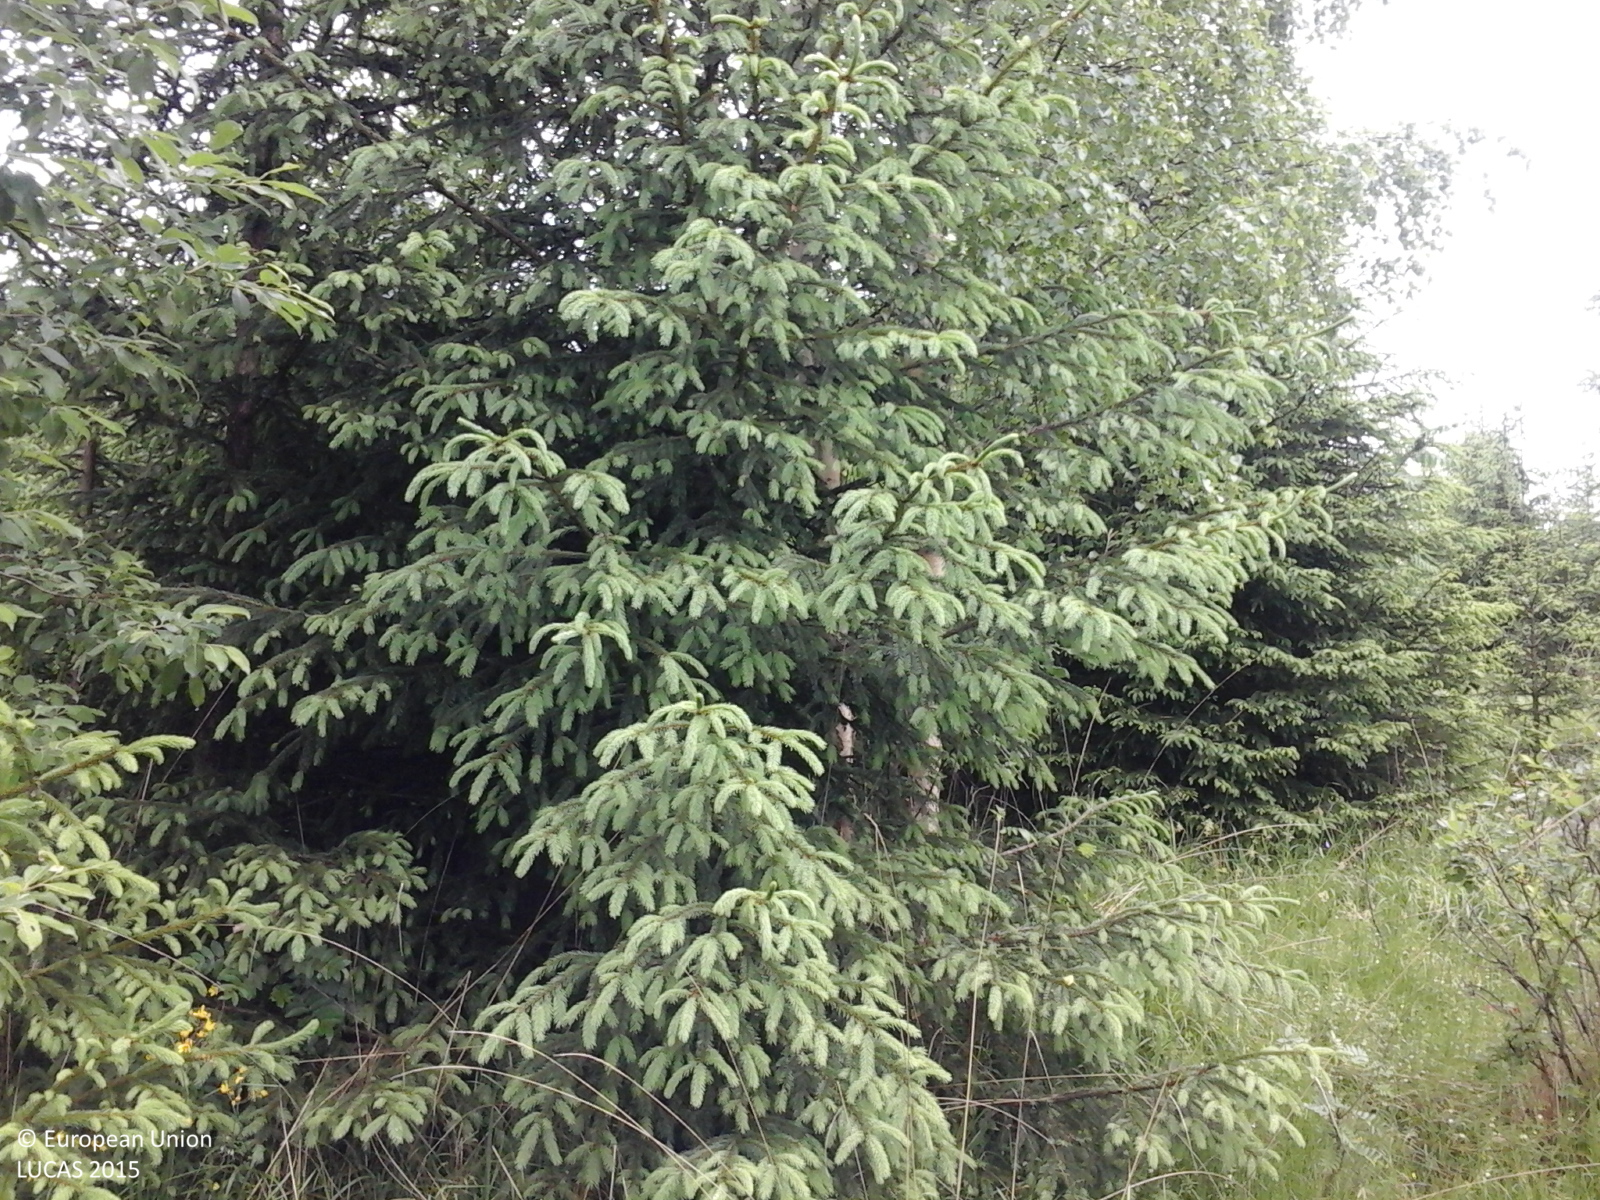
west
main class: Woodland
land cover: Spruce dominated coniferous woodland
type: alpine coniferous forest
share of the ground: > 75 %
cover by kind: coniferous forest trees 75 %, broadleaved forest trees 10 %, herbaceous plants 10 %, shrubs 5 %
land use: Forestry
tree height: > 5 m
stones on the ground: 25 - 50 %
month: June
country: RO
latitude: 47.4550
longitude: 25.3253
